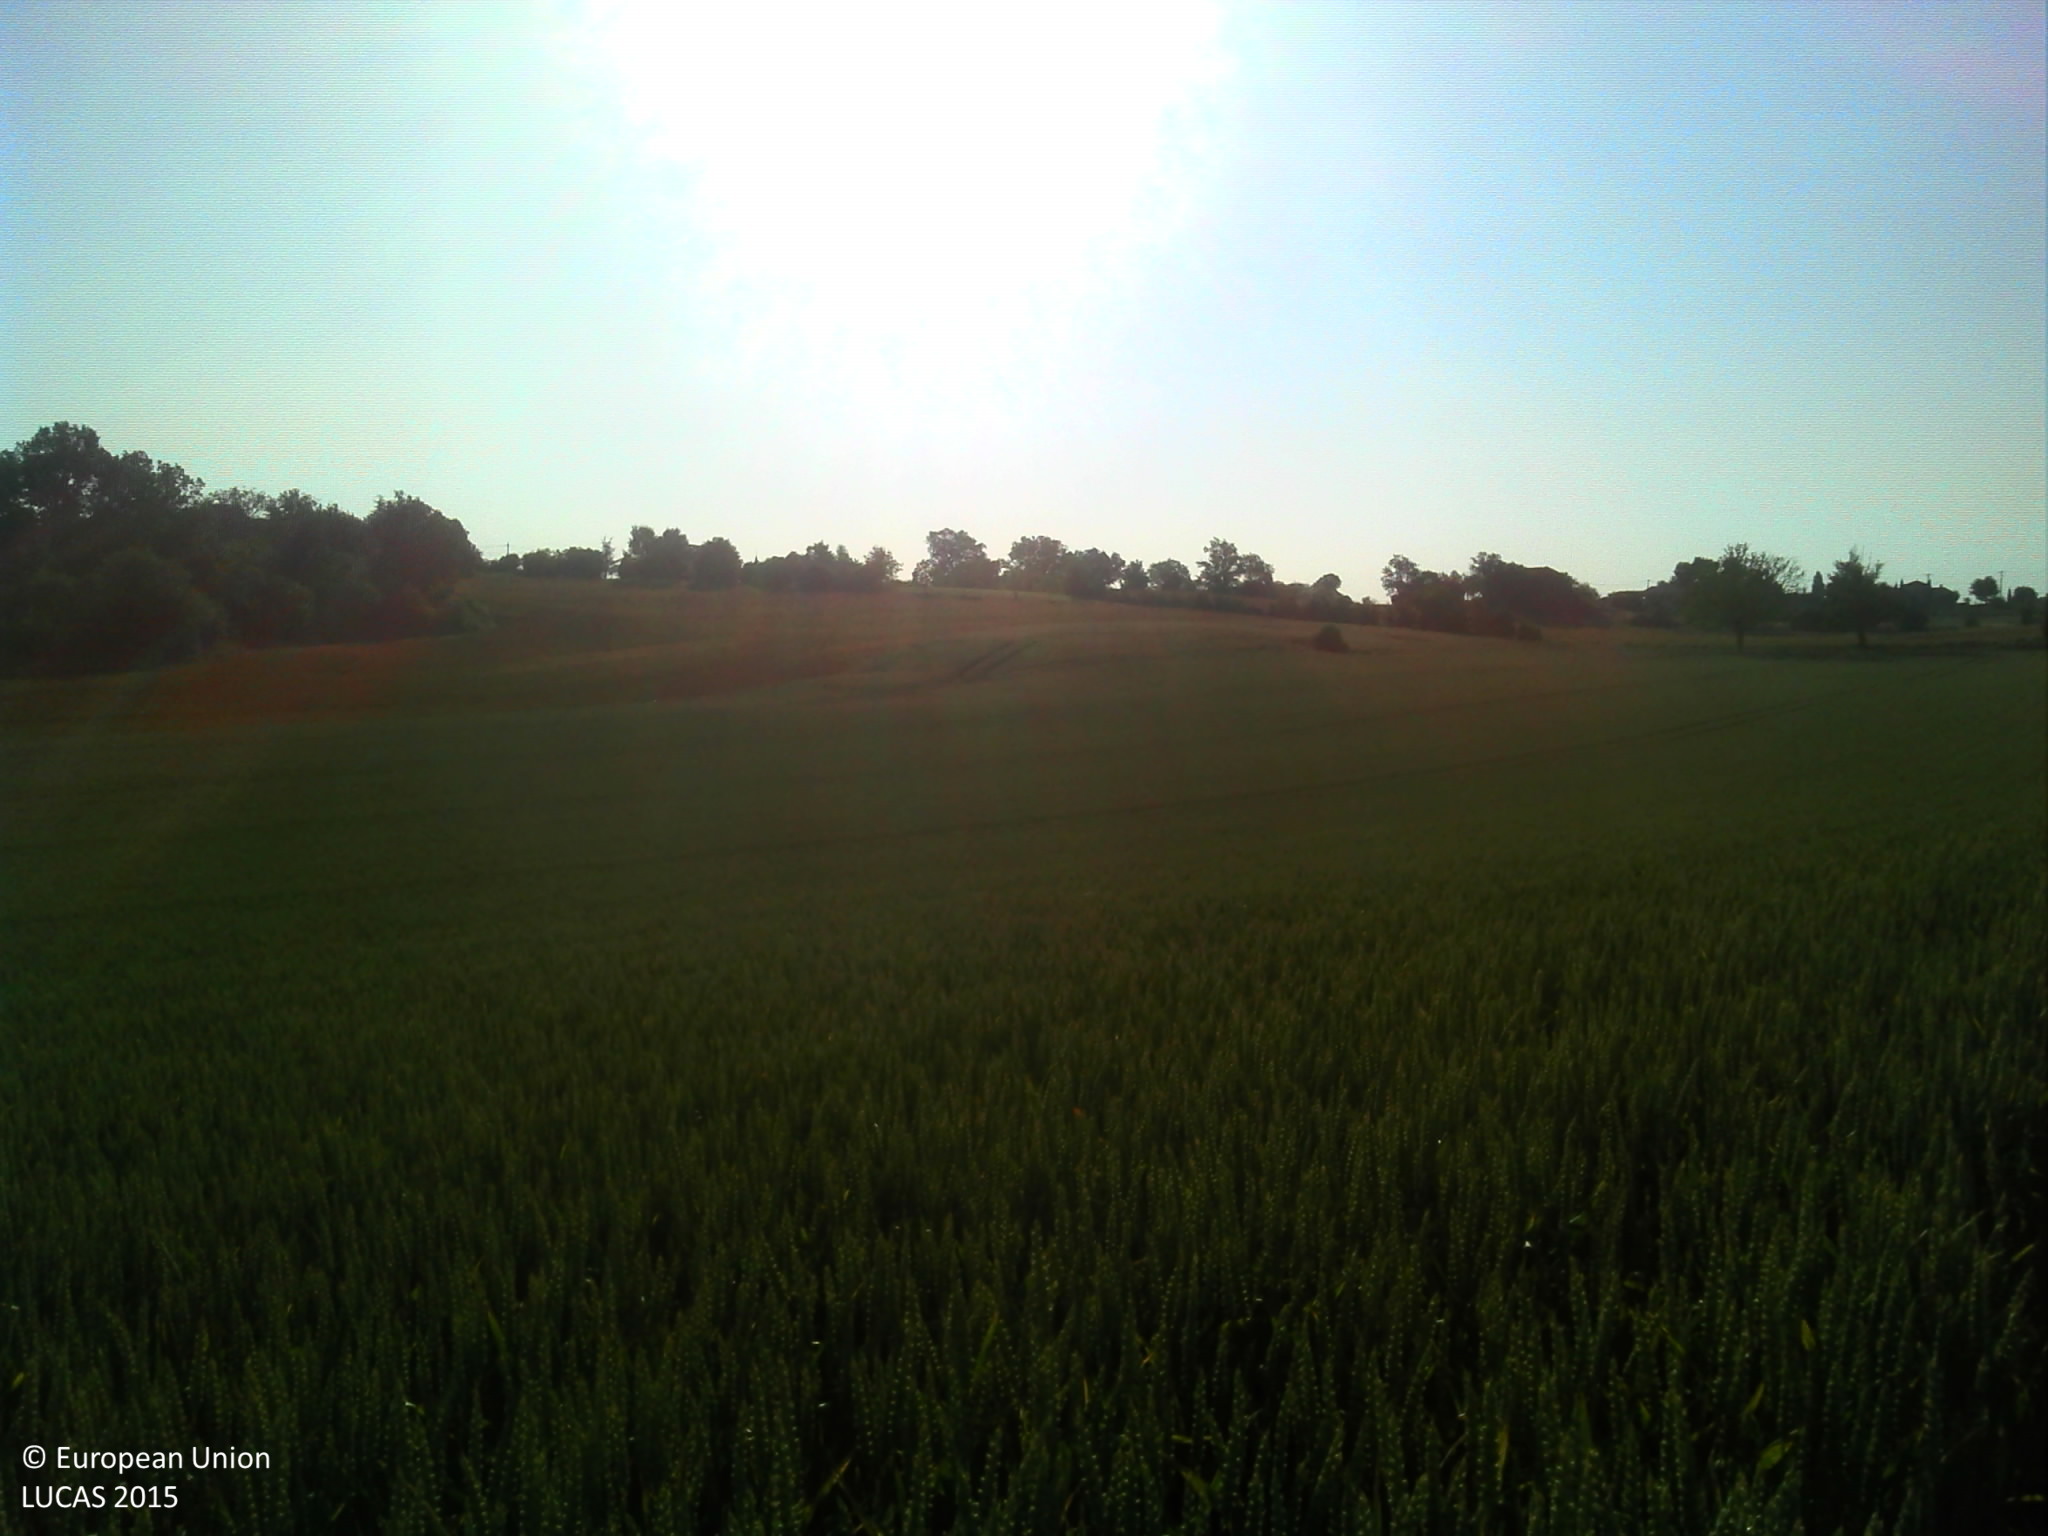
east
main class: Cropland
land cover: Common wheat
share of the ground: > 75 %
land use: Agriculture (excluding fallow land and kitchen gardens)
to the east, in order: Common wheat
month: June
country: FR
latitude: 43.8860
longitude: 2.1000
